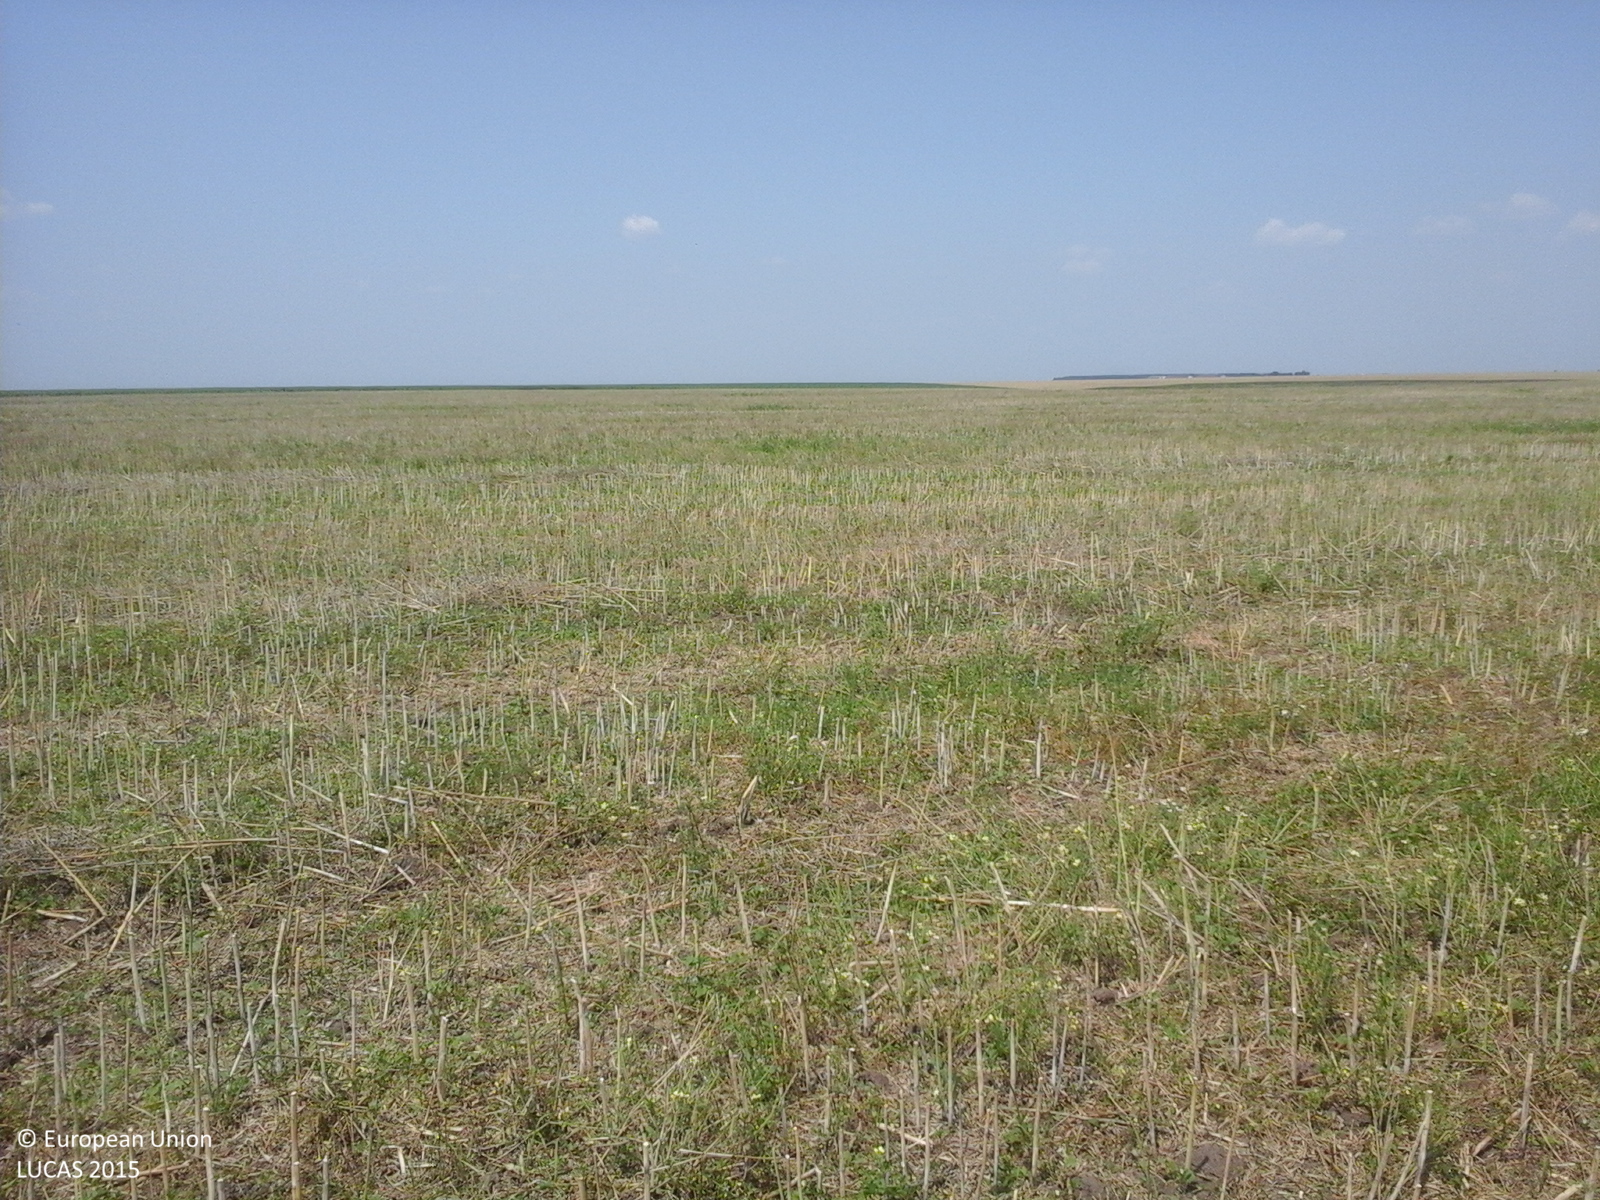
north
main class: Cropland
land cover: Rape and turnip rape
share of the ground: < 10 %
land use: Agriculture (excluding fallow land and kitchen gardens)
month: July
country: RO
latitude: 44.5187
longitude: 24.8610
